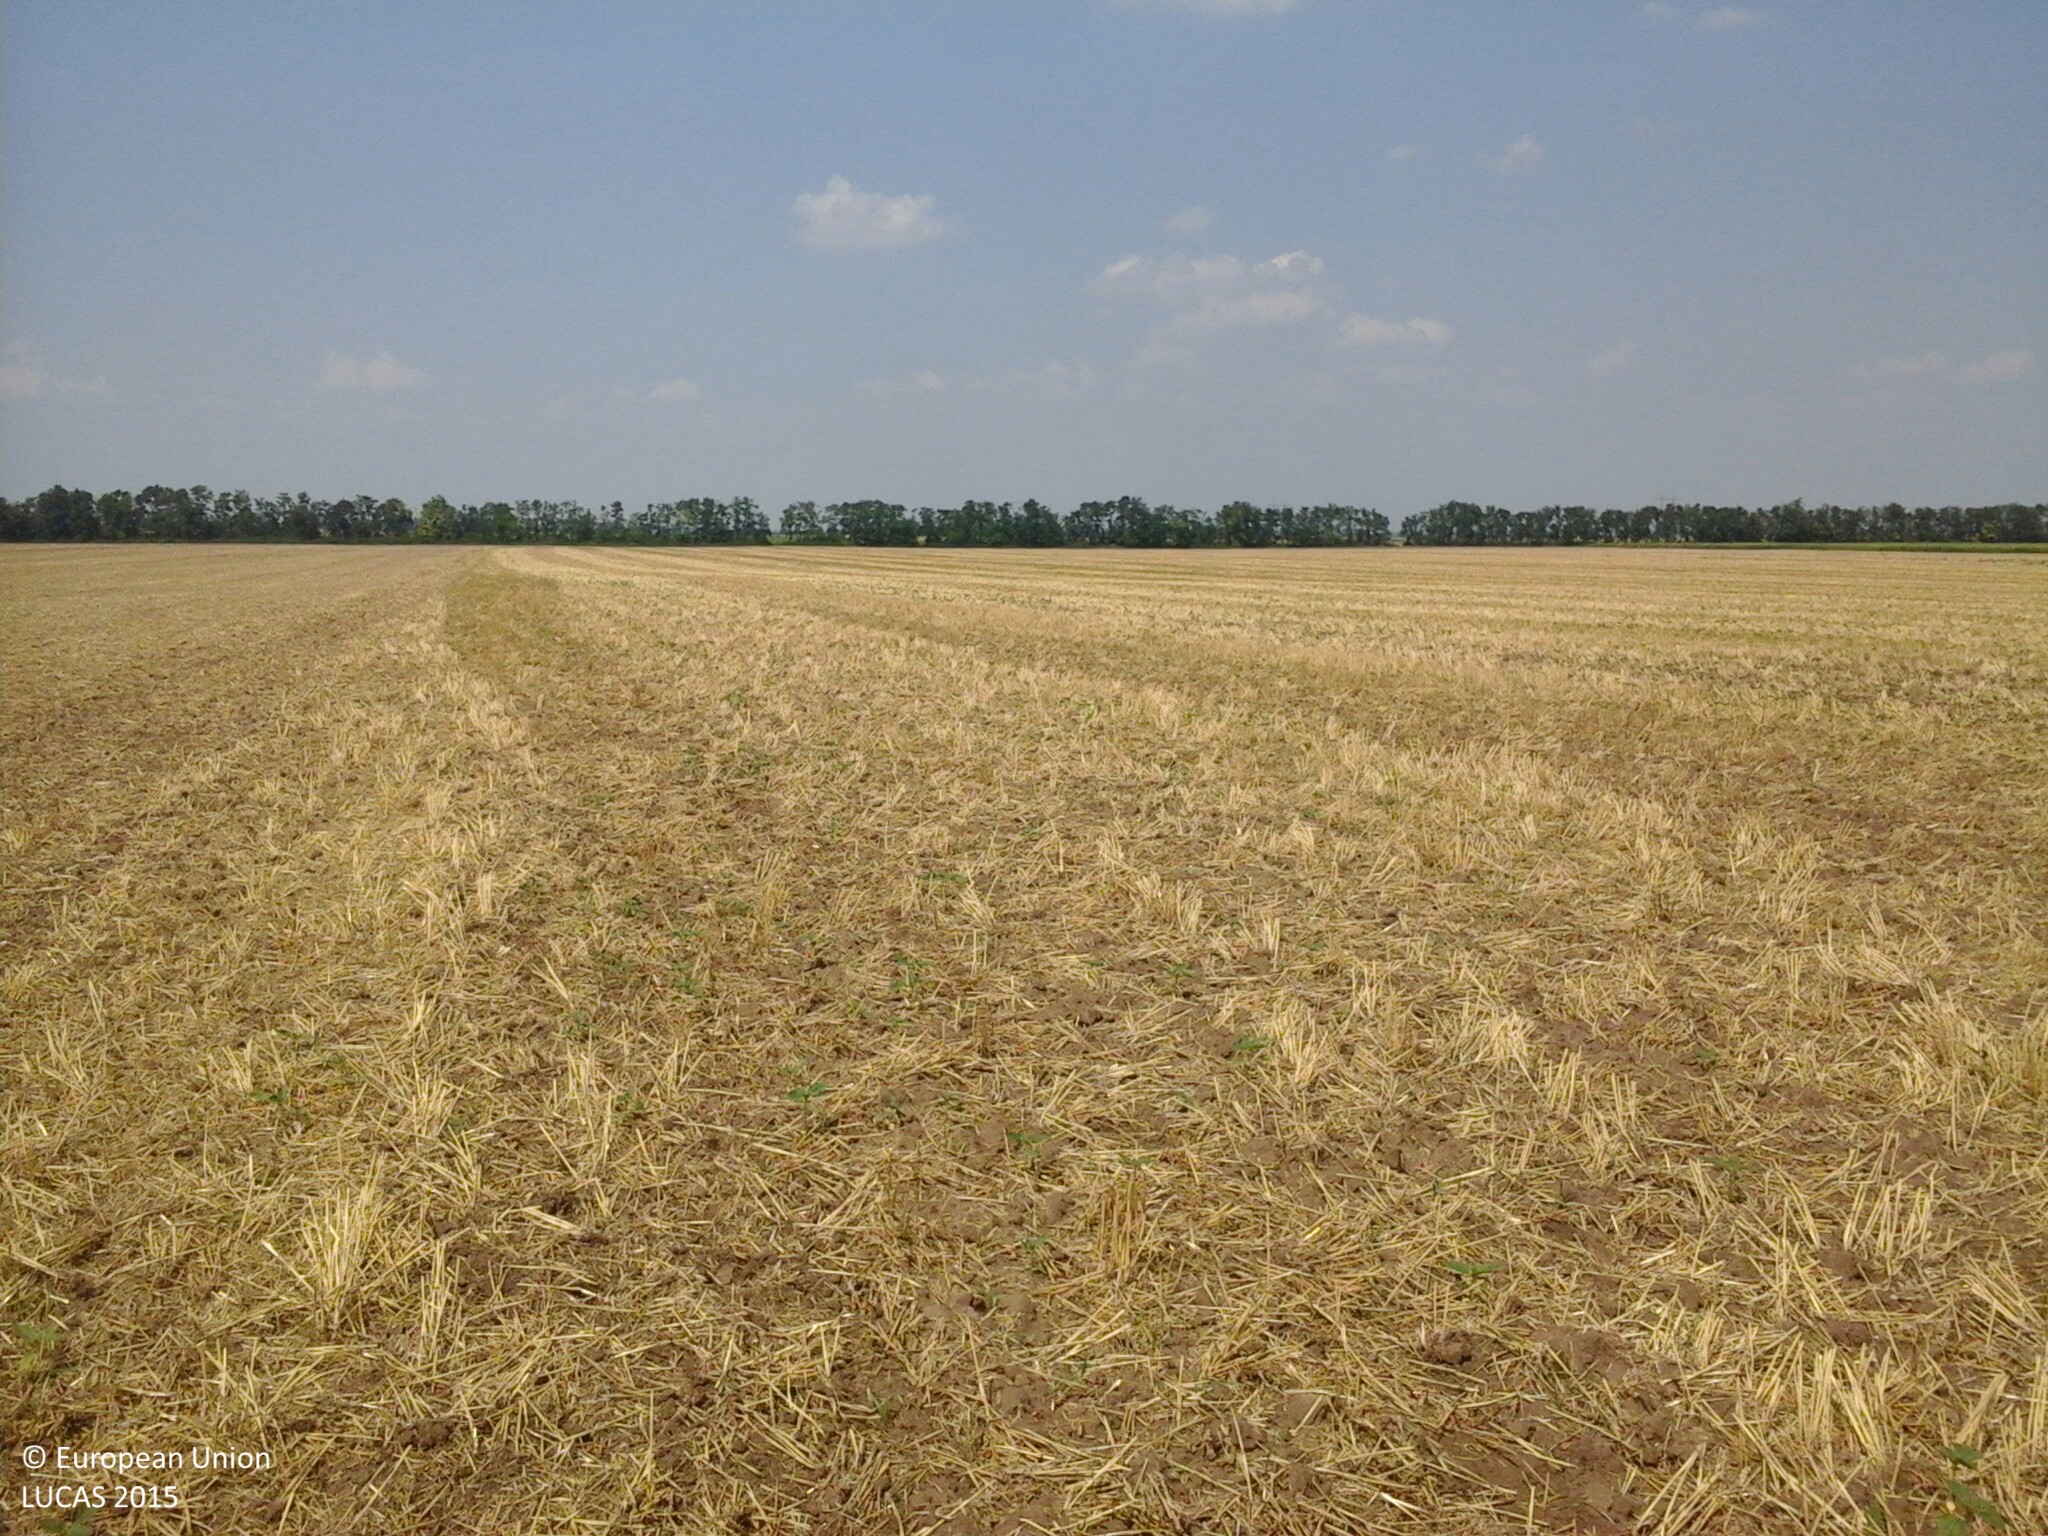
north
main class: Cropland
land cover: Common wheat
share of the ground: < 10 %
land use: Agriculture (excluding fallow land and kitchen gardens)
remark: Harvested field
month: August
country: HU
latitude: 46.8756
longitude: 18.3424
